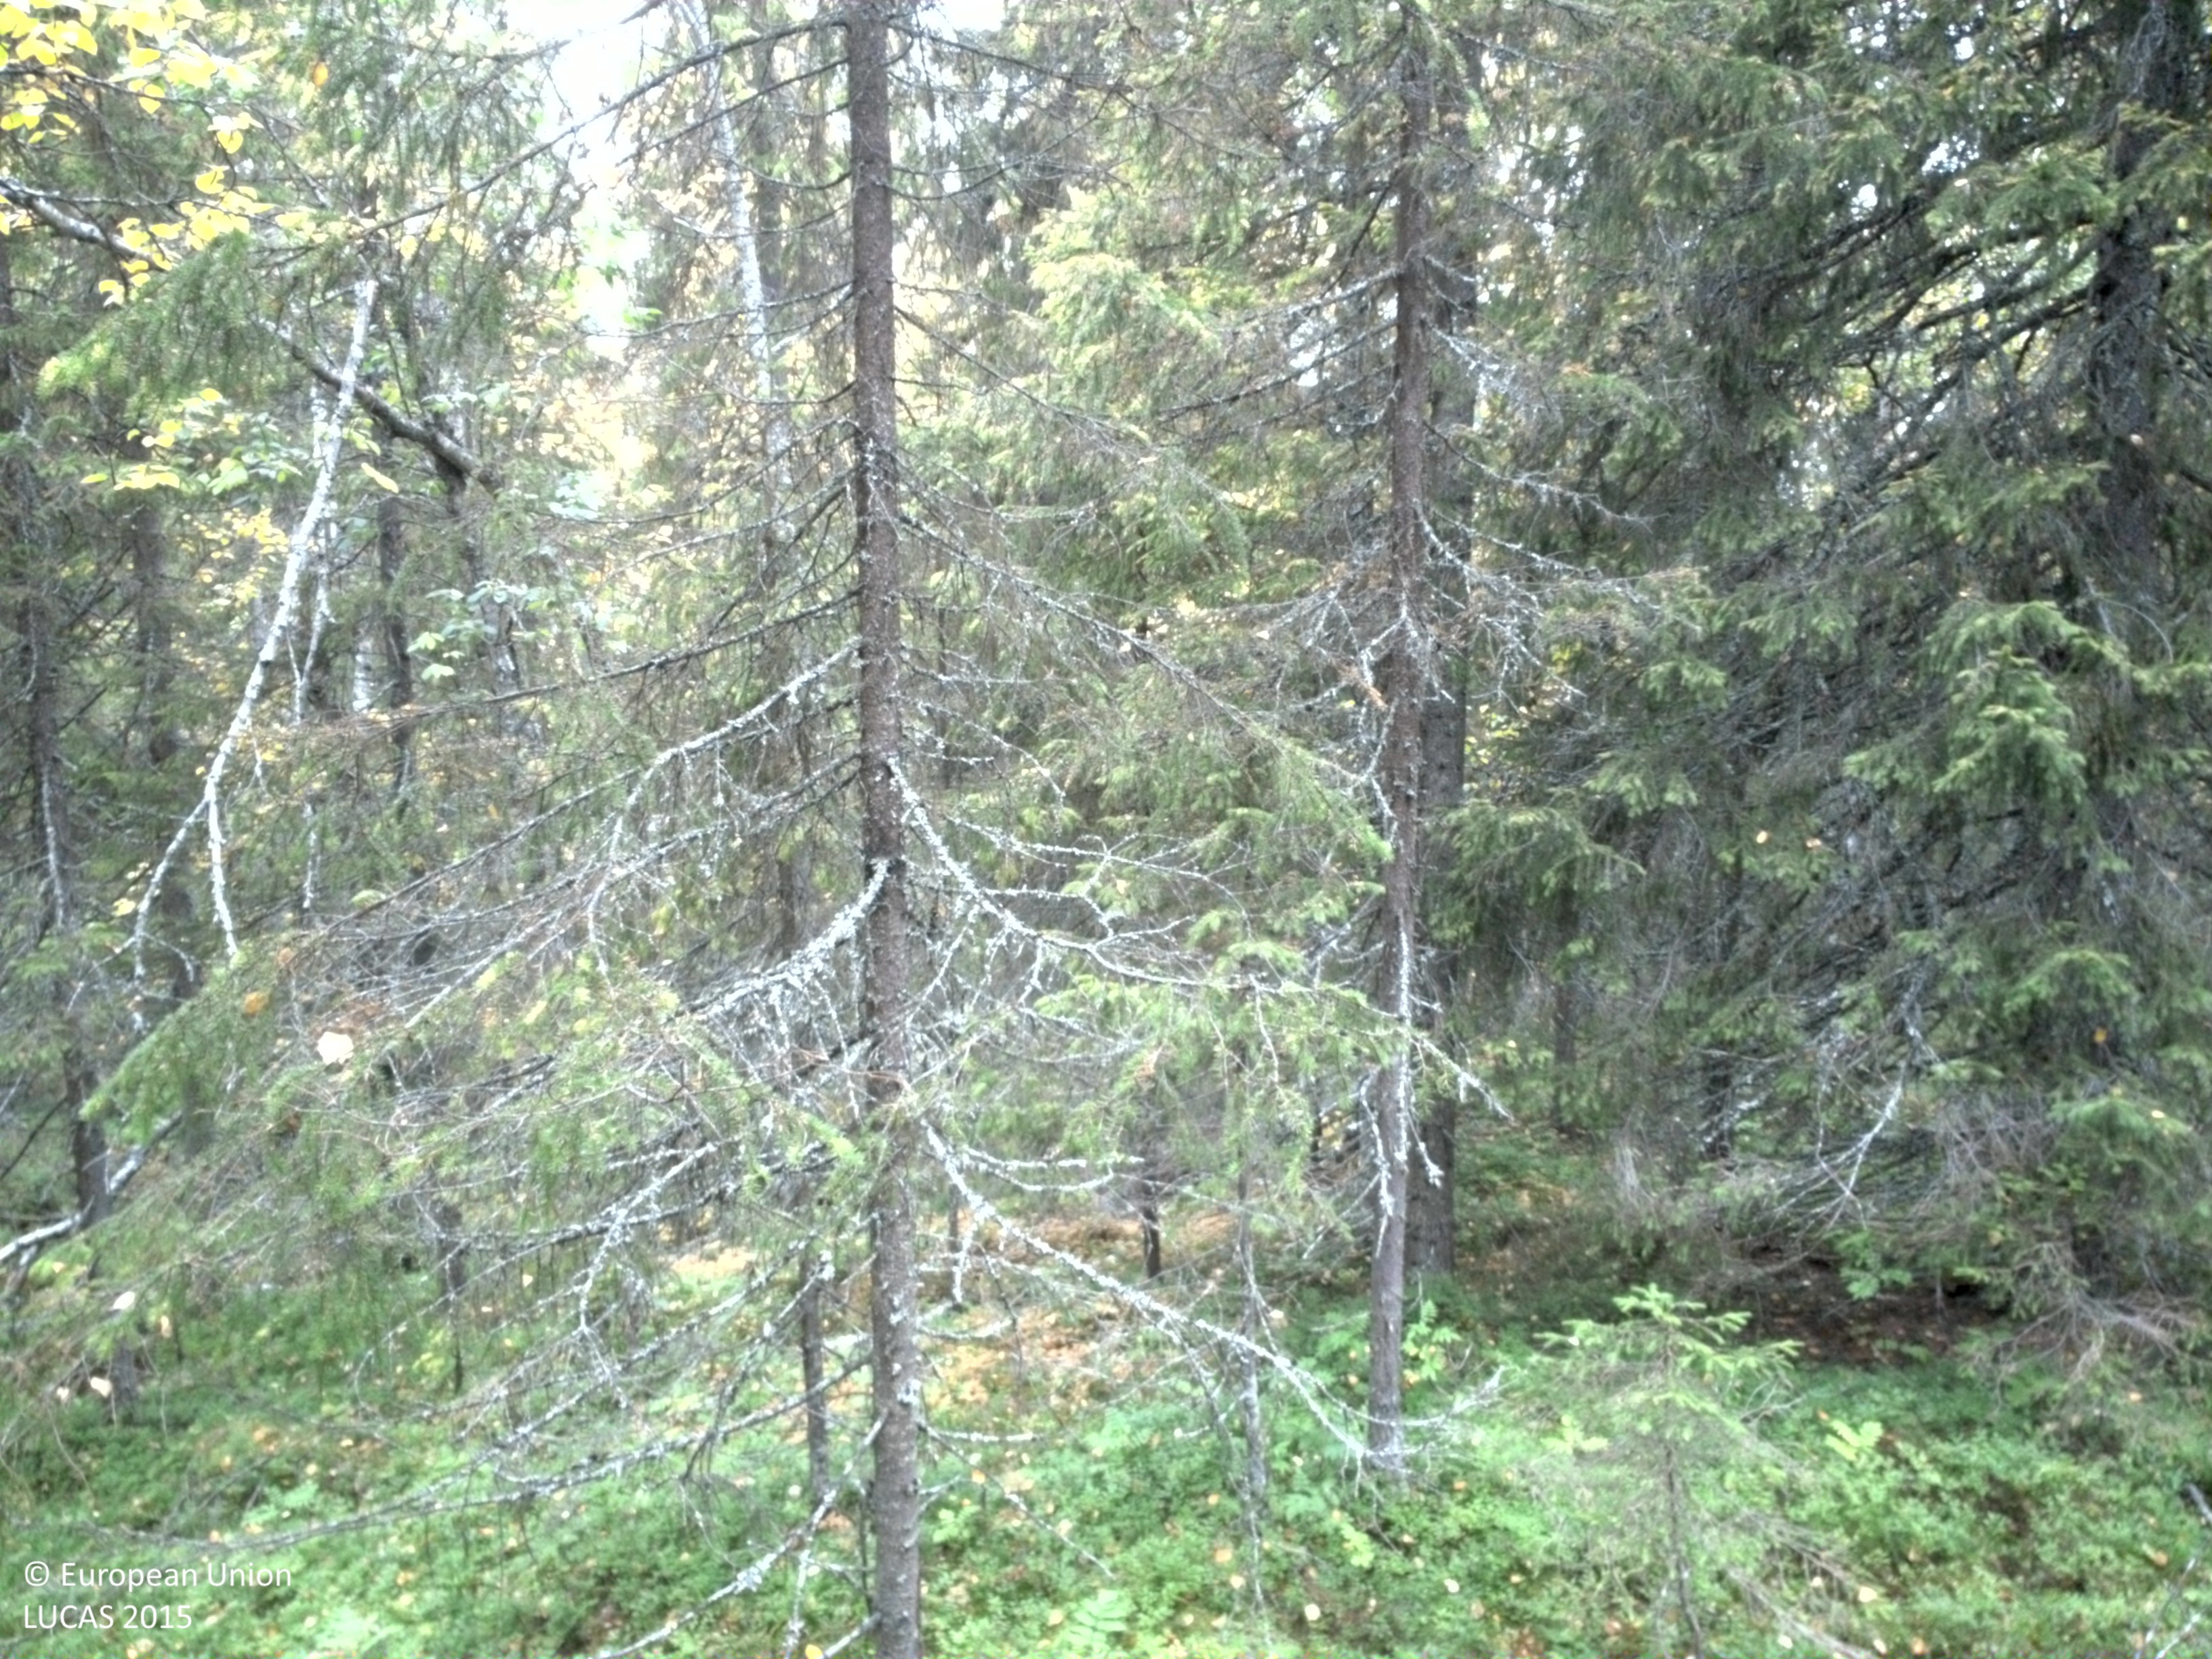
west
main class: Woodland
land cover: Spruce dominated mixed woodland
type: boreal forest
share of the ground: 25 - 50 %
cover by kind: shrubs 40 %, coniferous forest trees 25 %, lichens and mosses 15 %, broadleaved forest trees 10 %, herbaceous plants 10 %
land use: Forestry
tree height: > 5 m
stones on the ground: 10 - 25 %
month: September
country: SE
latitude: 65.1589
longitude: 16.8111
